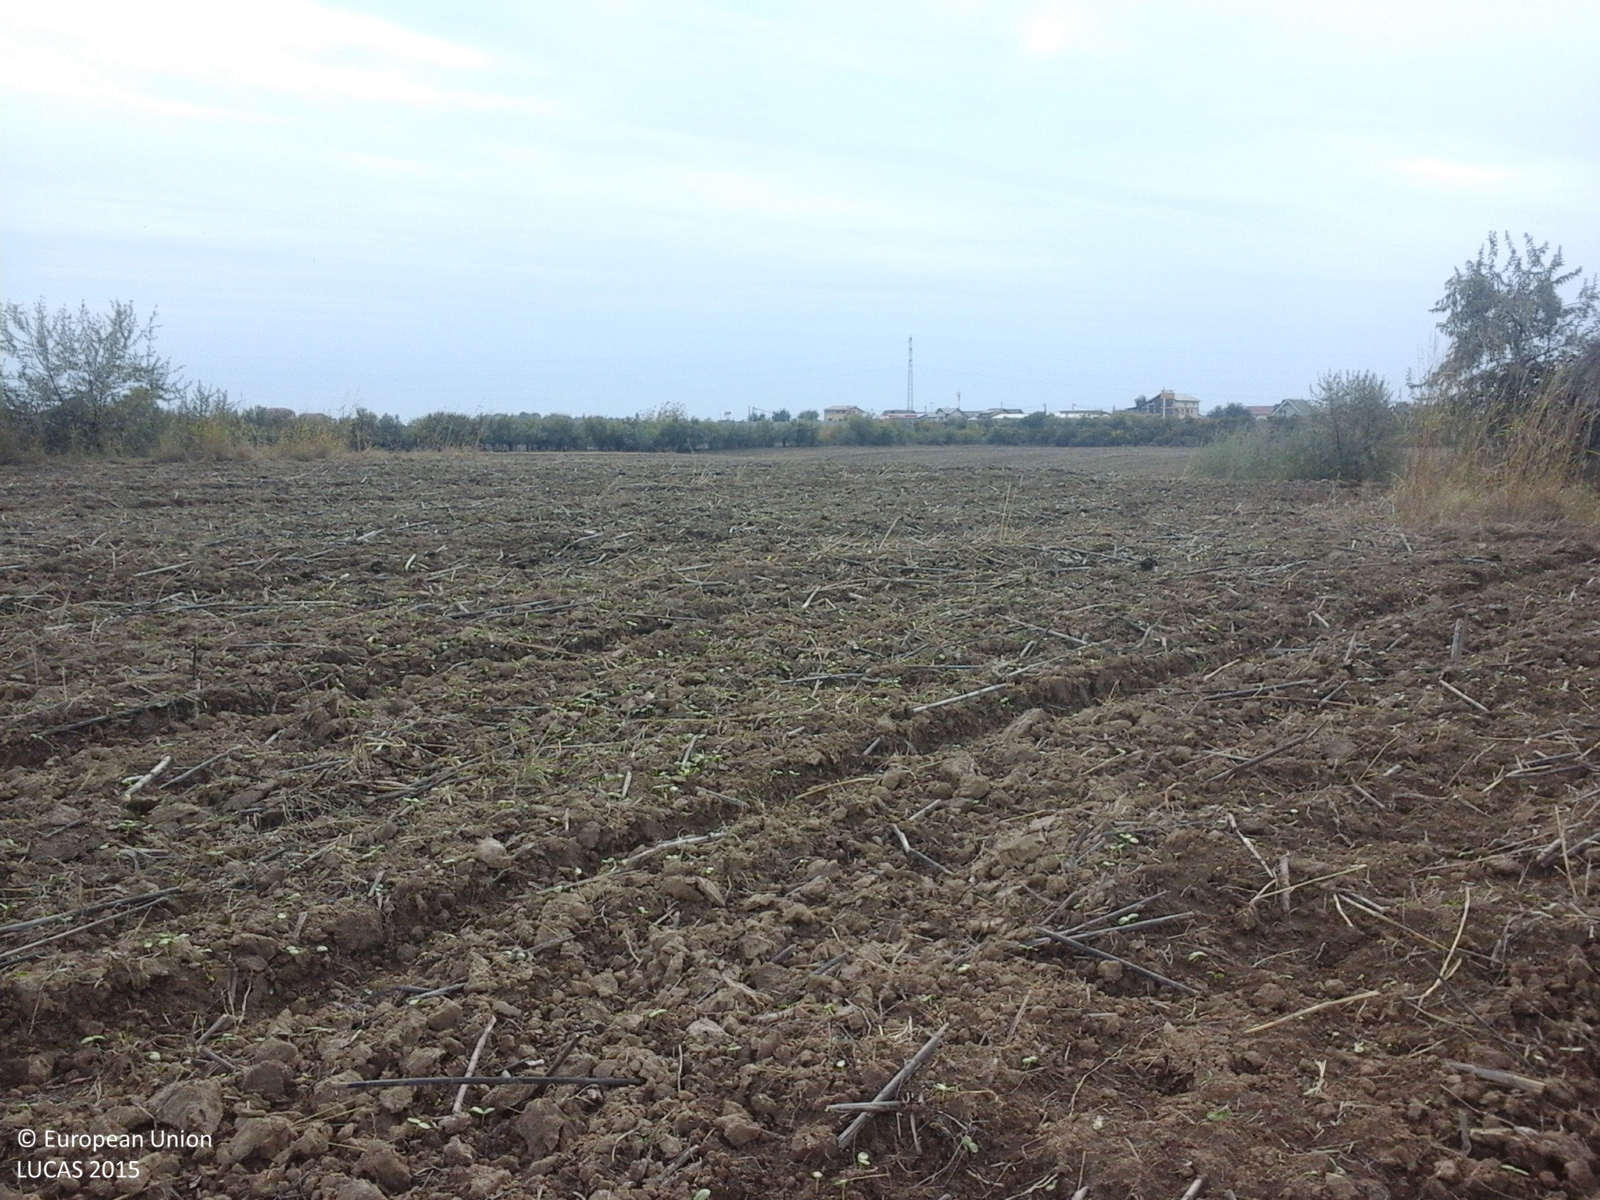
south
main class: Cropland
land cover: Sunflower
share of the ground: 10 - 25 %
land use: Agriculture (excluding fallow land and kitchen gardens)
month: October
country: RO
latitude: 44.9647
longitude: 26.0453
